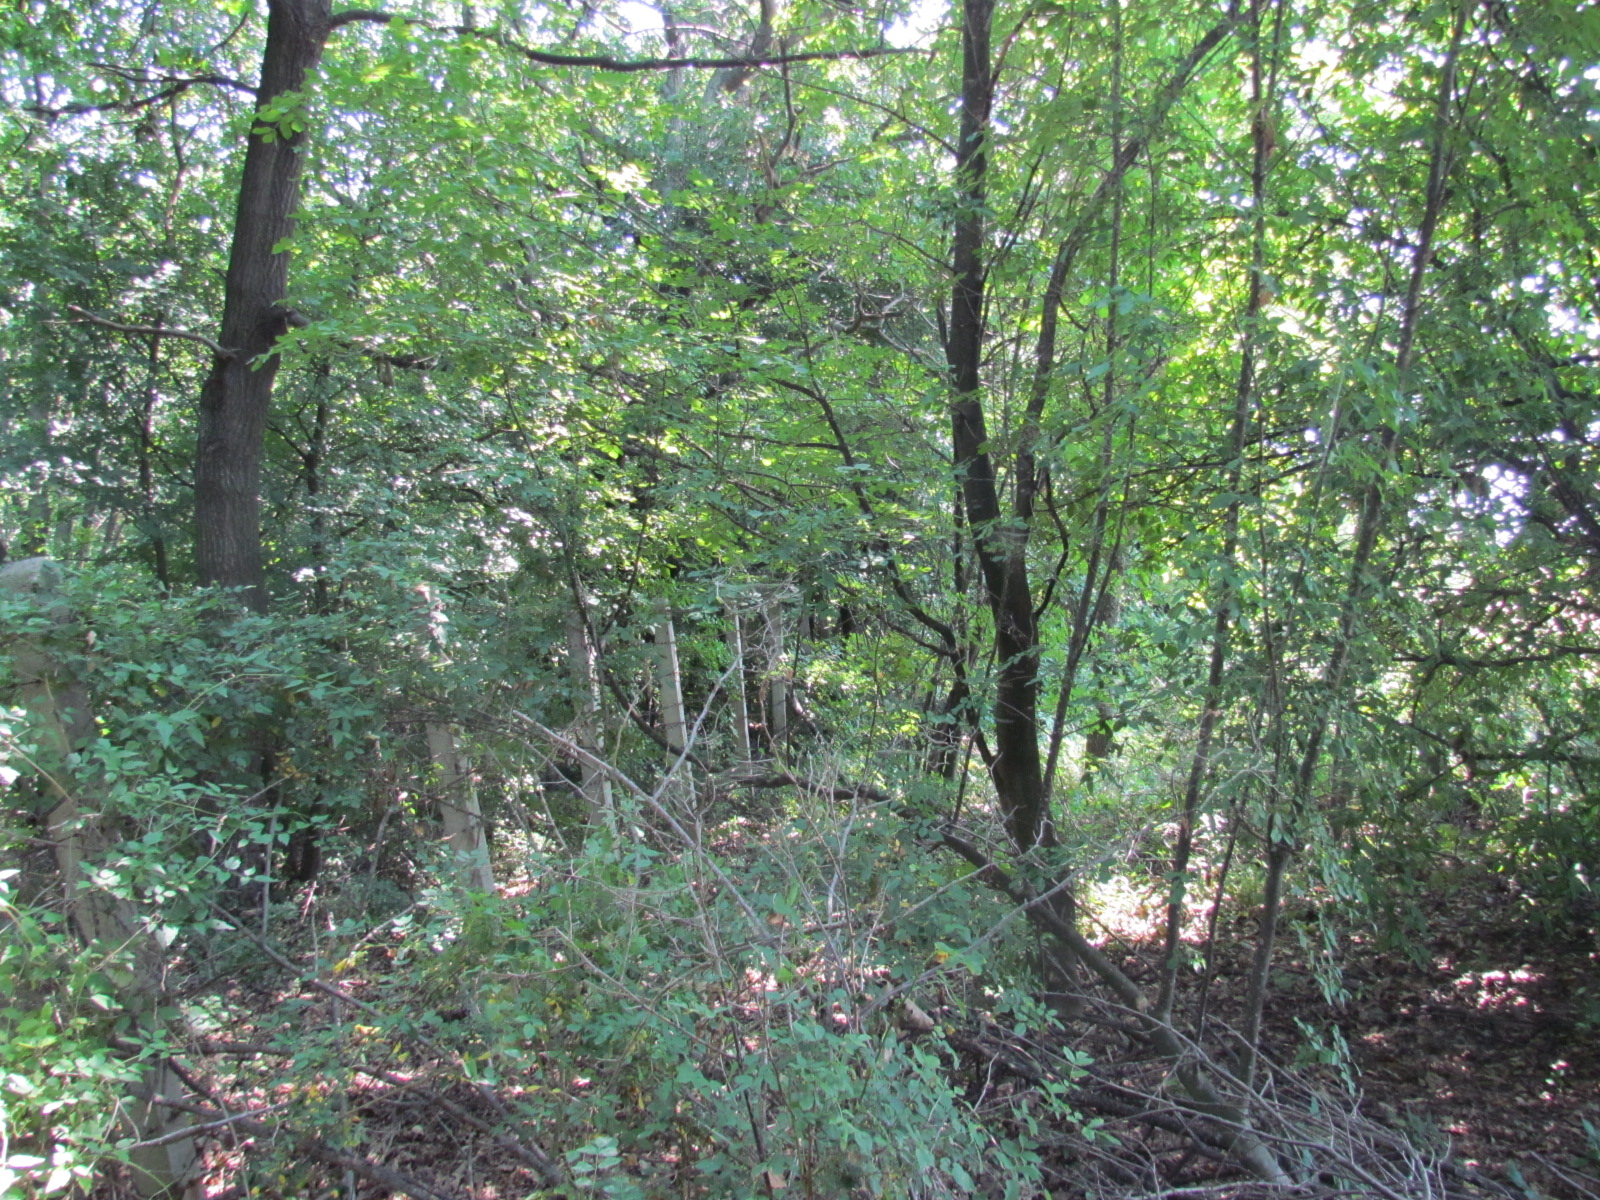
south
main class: Woodland
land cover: Broadleaved woodland
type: acidophilous oak and oak-birch forest
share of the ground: > 75 %
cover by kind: broadleaved forest trees 95 %, shrubs 5 %
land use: Forestry
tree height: > 5 m
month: July
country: BG
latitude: 42.7797
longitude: 27.8929
